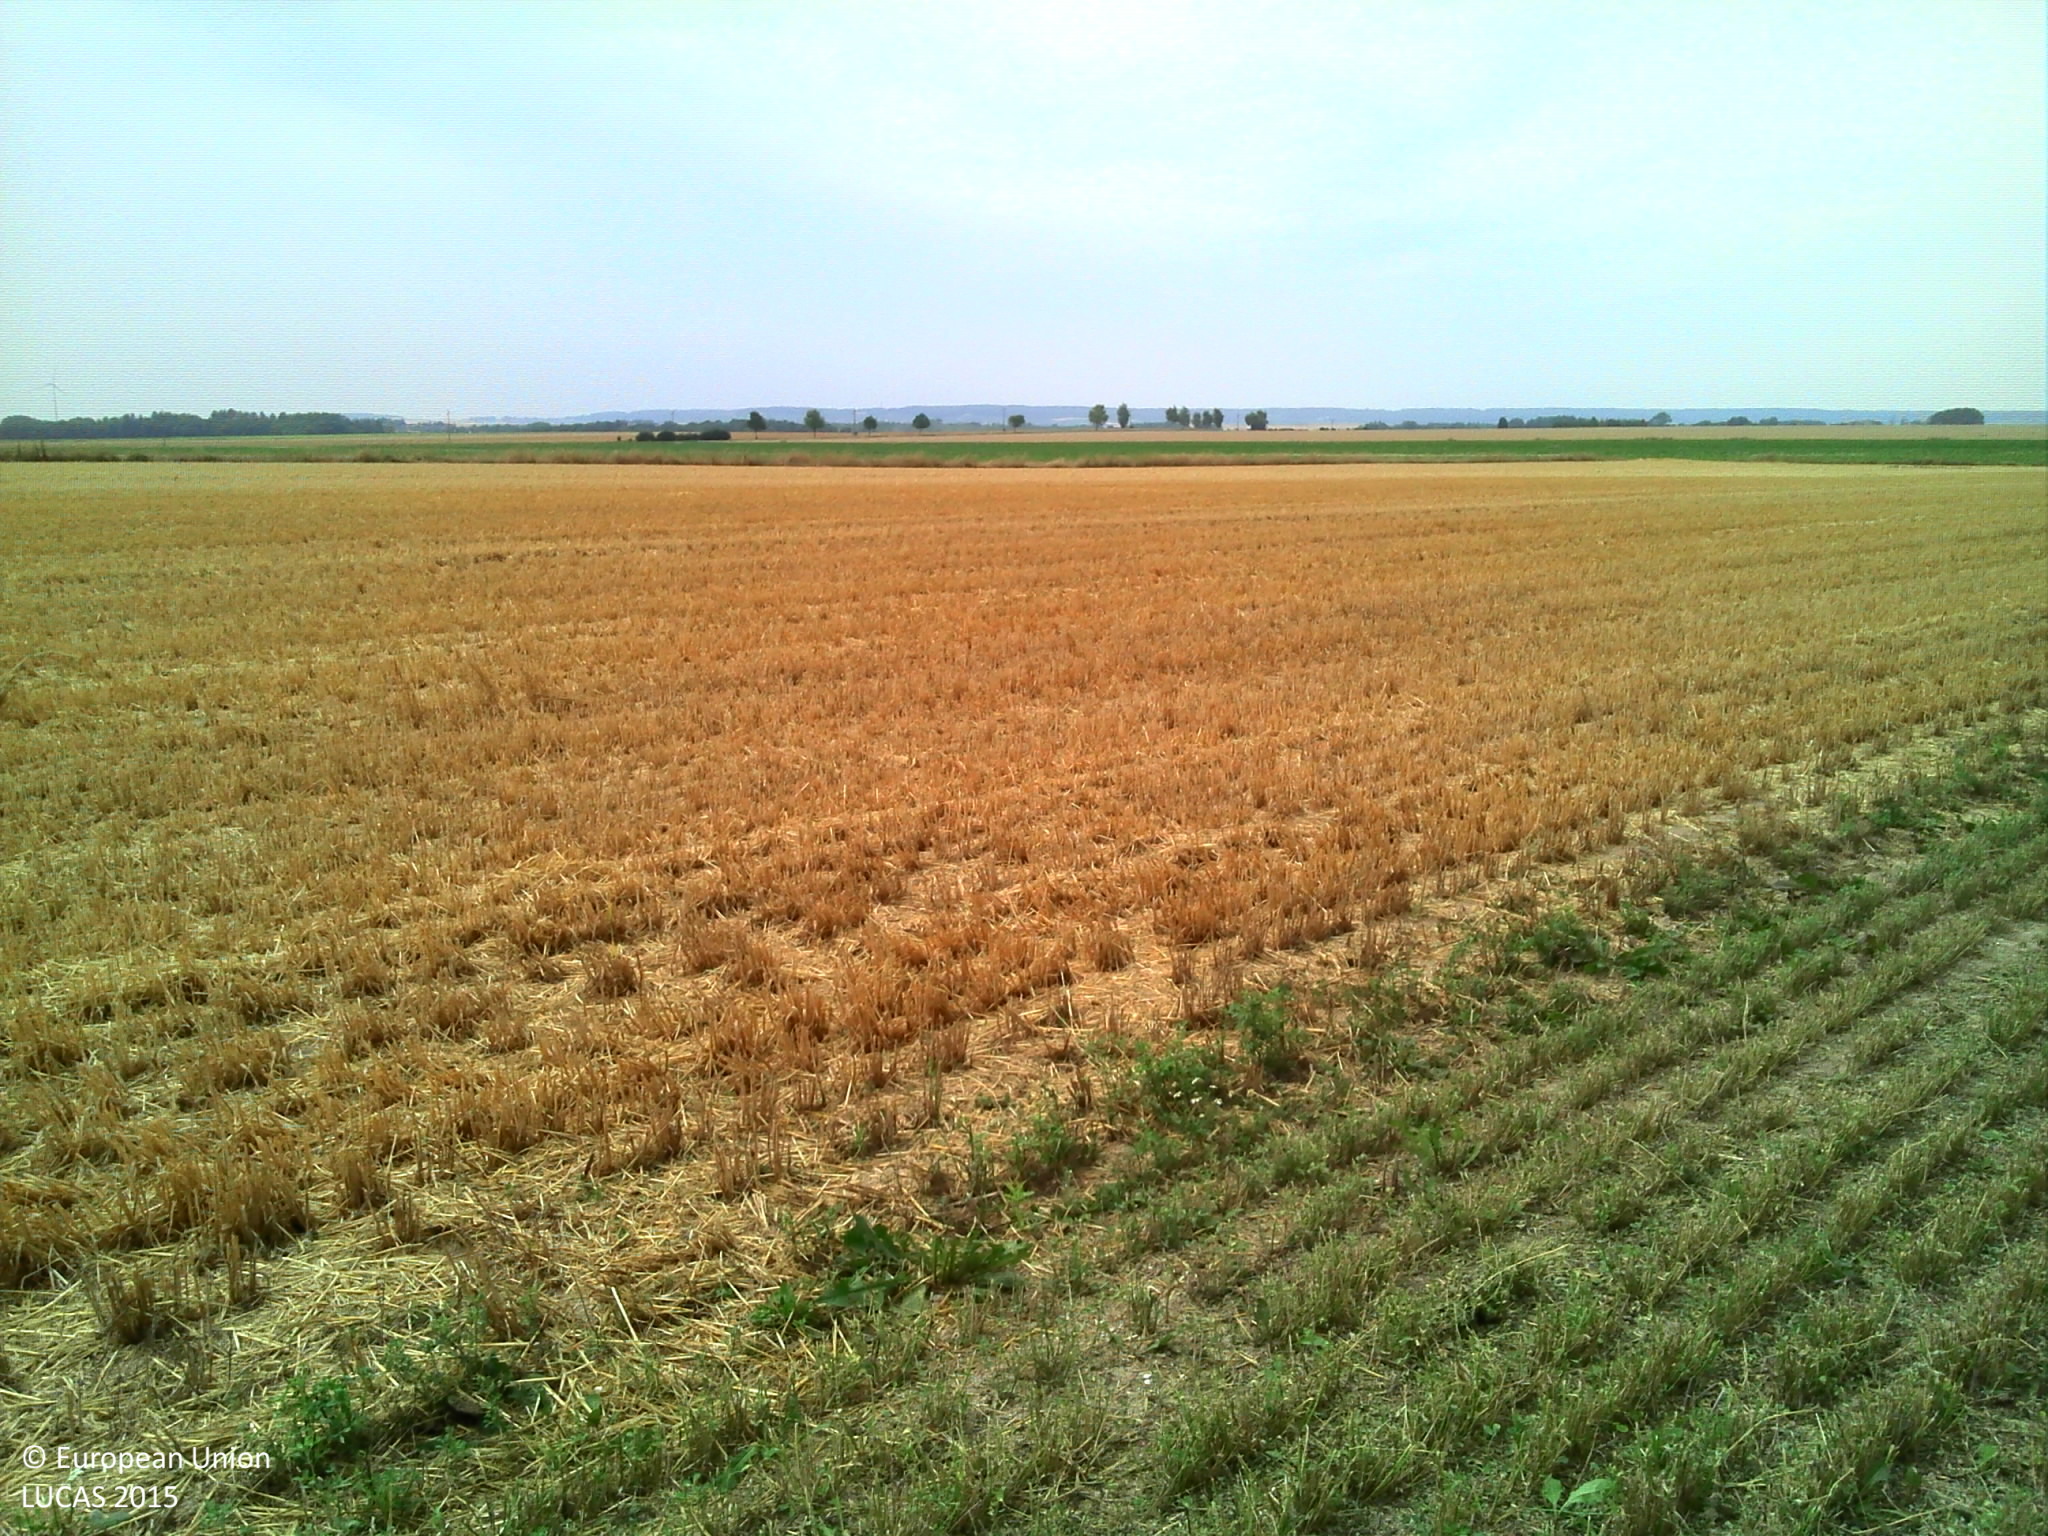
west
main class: Cropland
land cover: Lucerne
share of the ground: > 75 %
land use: Agriculture (excluding fallow land and kitchen gardens)
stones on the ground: < 10 %
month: August
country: FR
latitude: 48.6262
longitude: 3.7946
